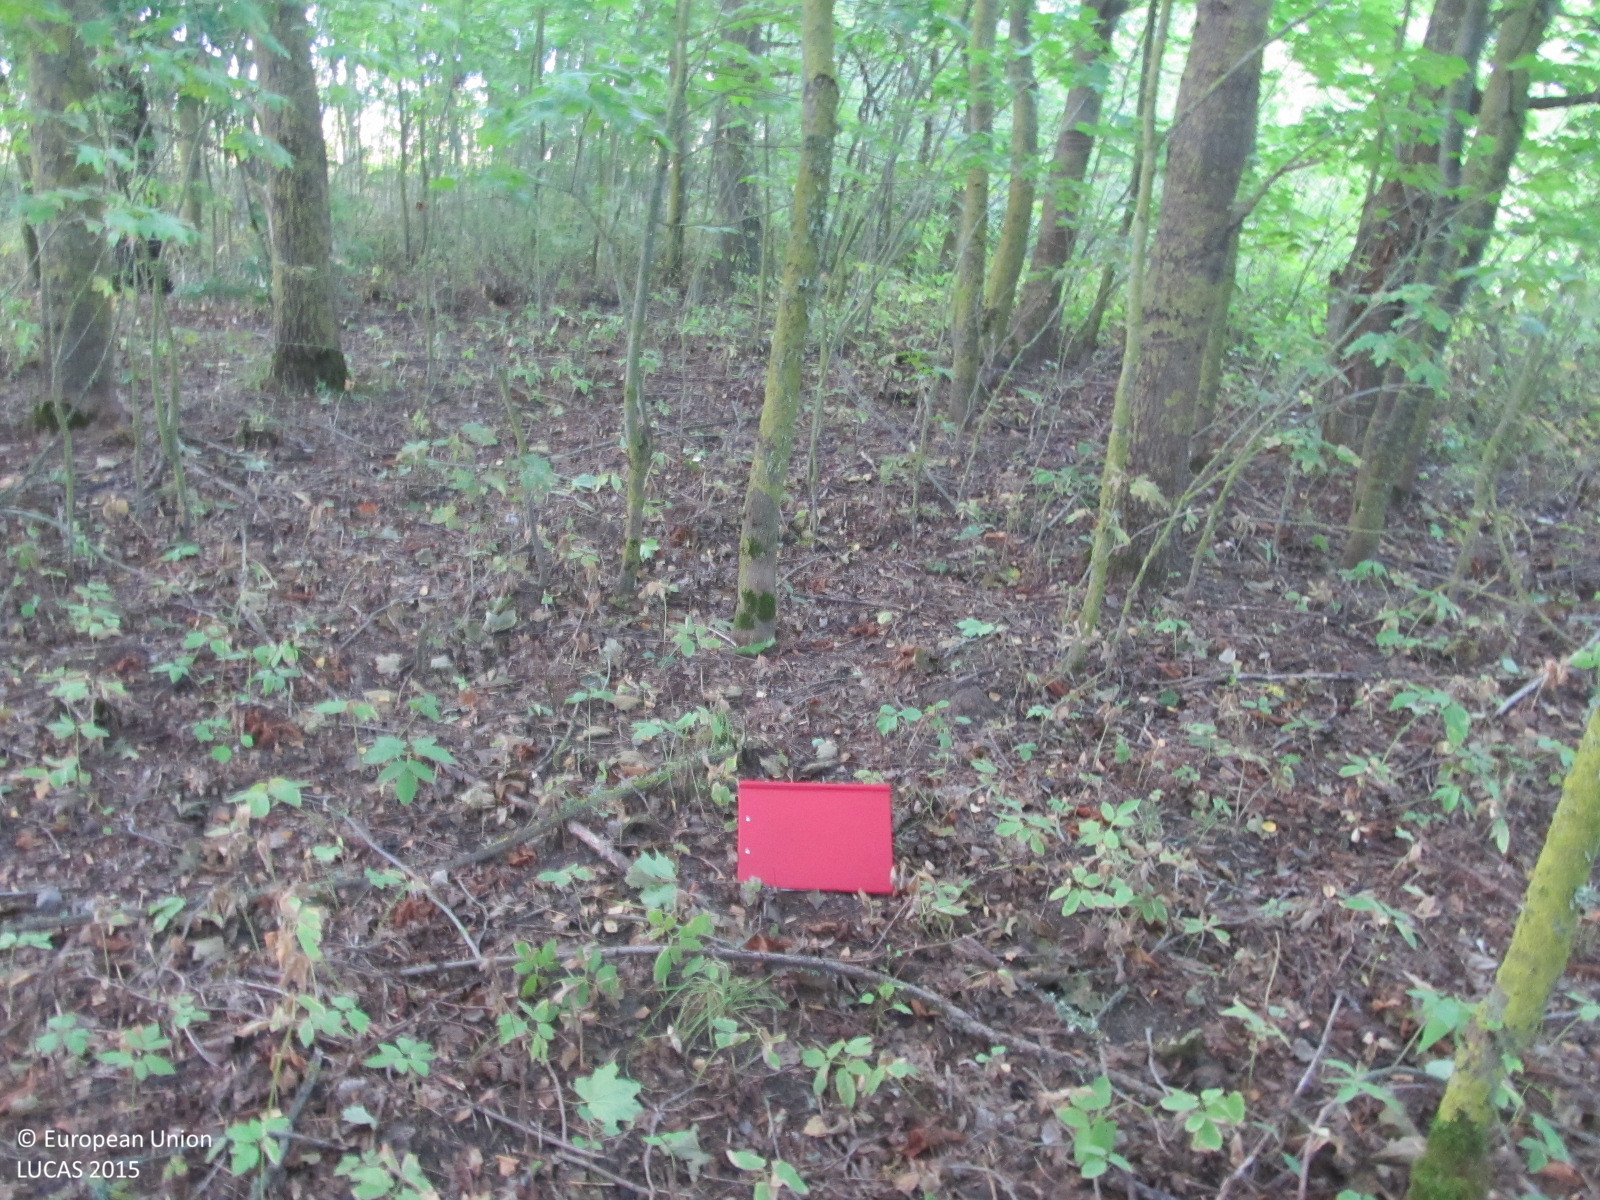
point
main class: Woodland
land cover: Broadleaved woodland
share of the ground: > 75 %
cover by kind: broadleaved forest trees 90 %, herbaceous plants 5 %, unconsolidated bare surface 5 %
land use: Forestry
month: September
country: LT
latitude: 56.3324
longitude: 23.2859
